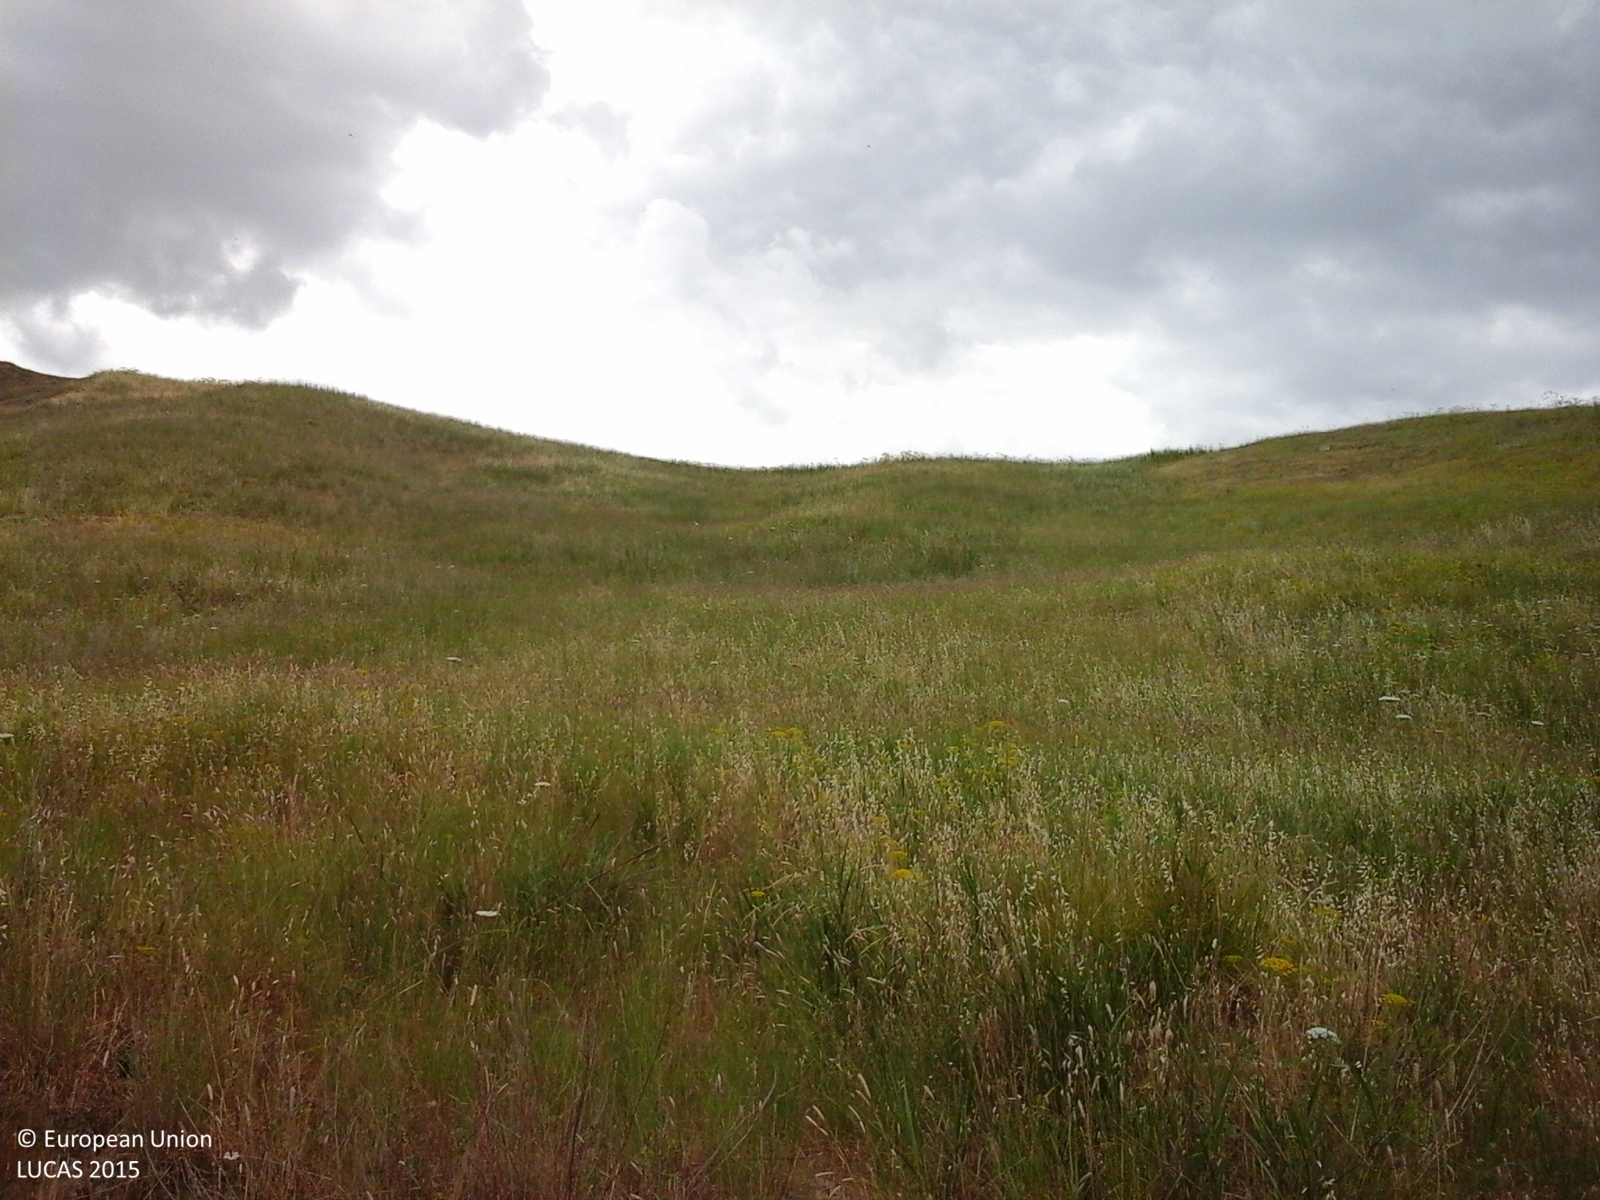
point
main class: Grassland
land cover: Grassland without tree/shrub cover
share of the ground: > 75 %
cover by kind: herbaceous plants 100 %
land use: Semi-natural and natural areas not in use
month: June
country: IT
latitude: 37.5511
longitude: 13.6288
